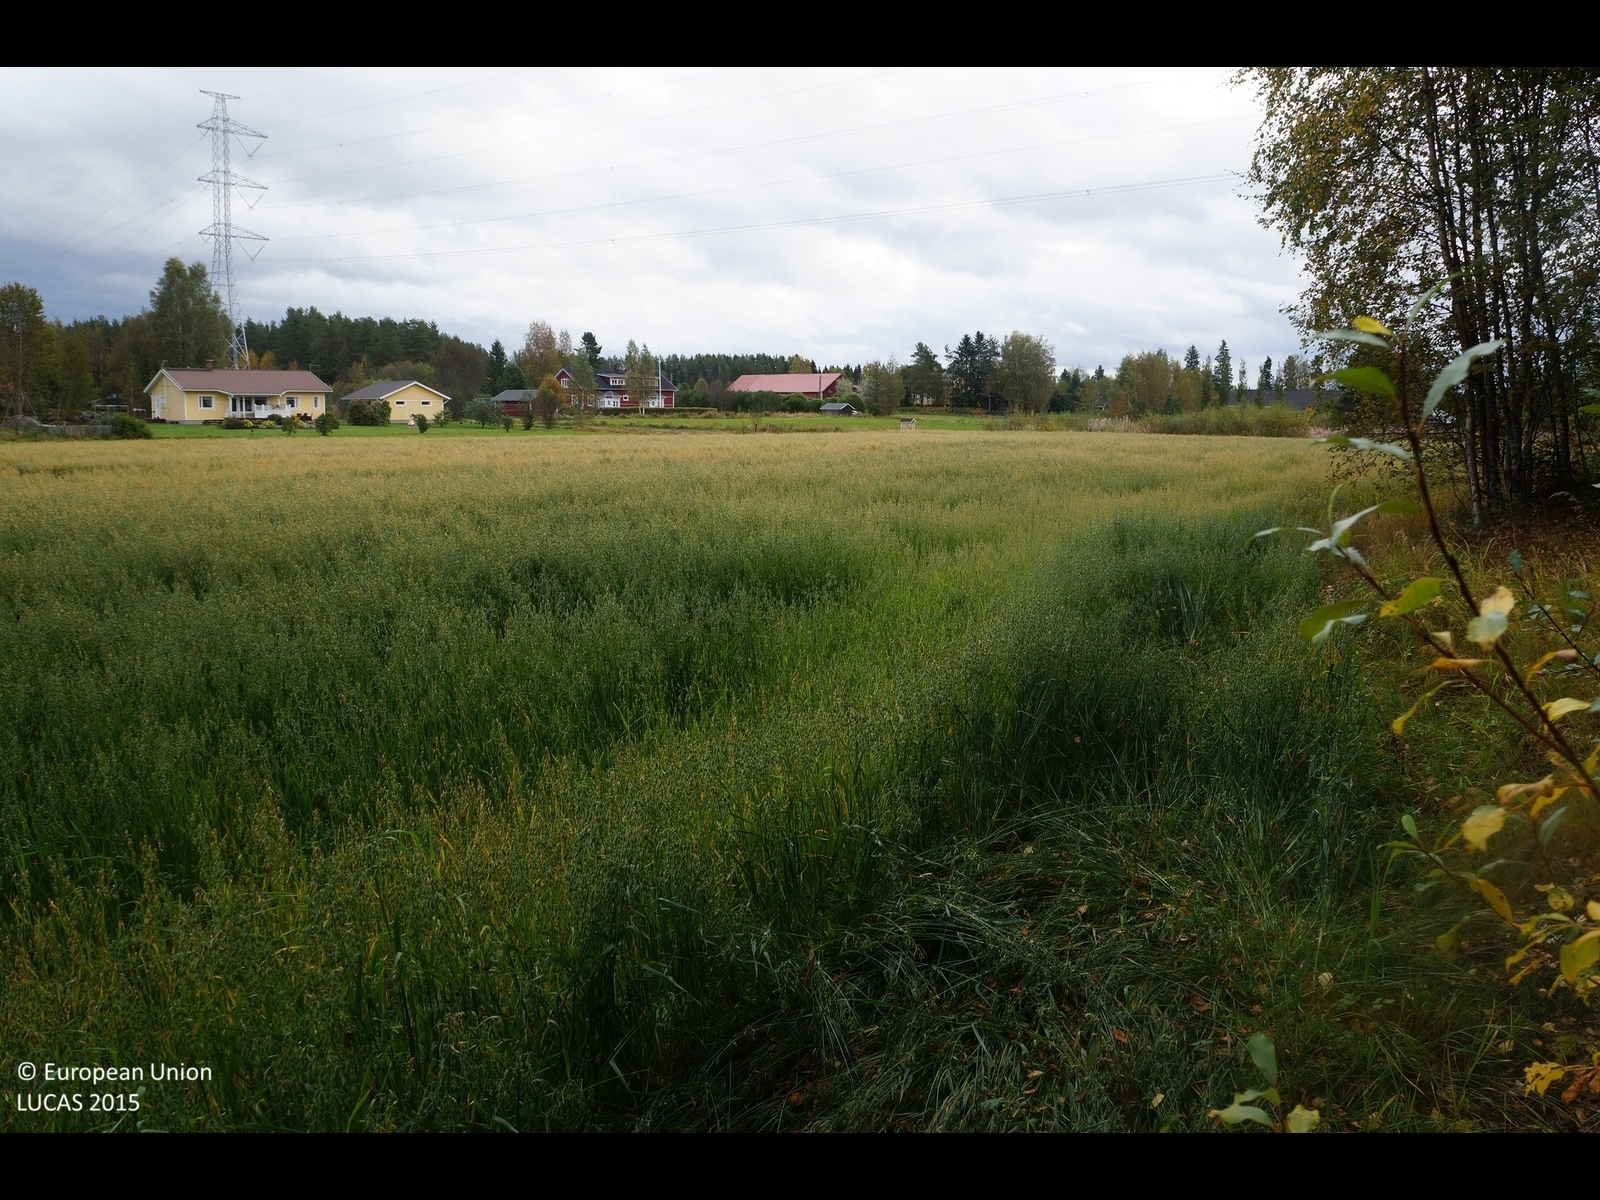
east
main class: Cropland
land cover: Oats
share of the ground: > 75 %
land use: Agriculture (excluding fallow land and kitchen gardens)
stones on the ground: < 10 %
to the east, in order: Oats; Ditches and canals; Oats; Ditches and canals; Artificial constructions in urban areas
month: September
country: FI
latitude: 63.8506
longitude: 23.3362
